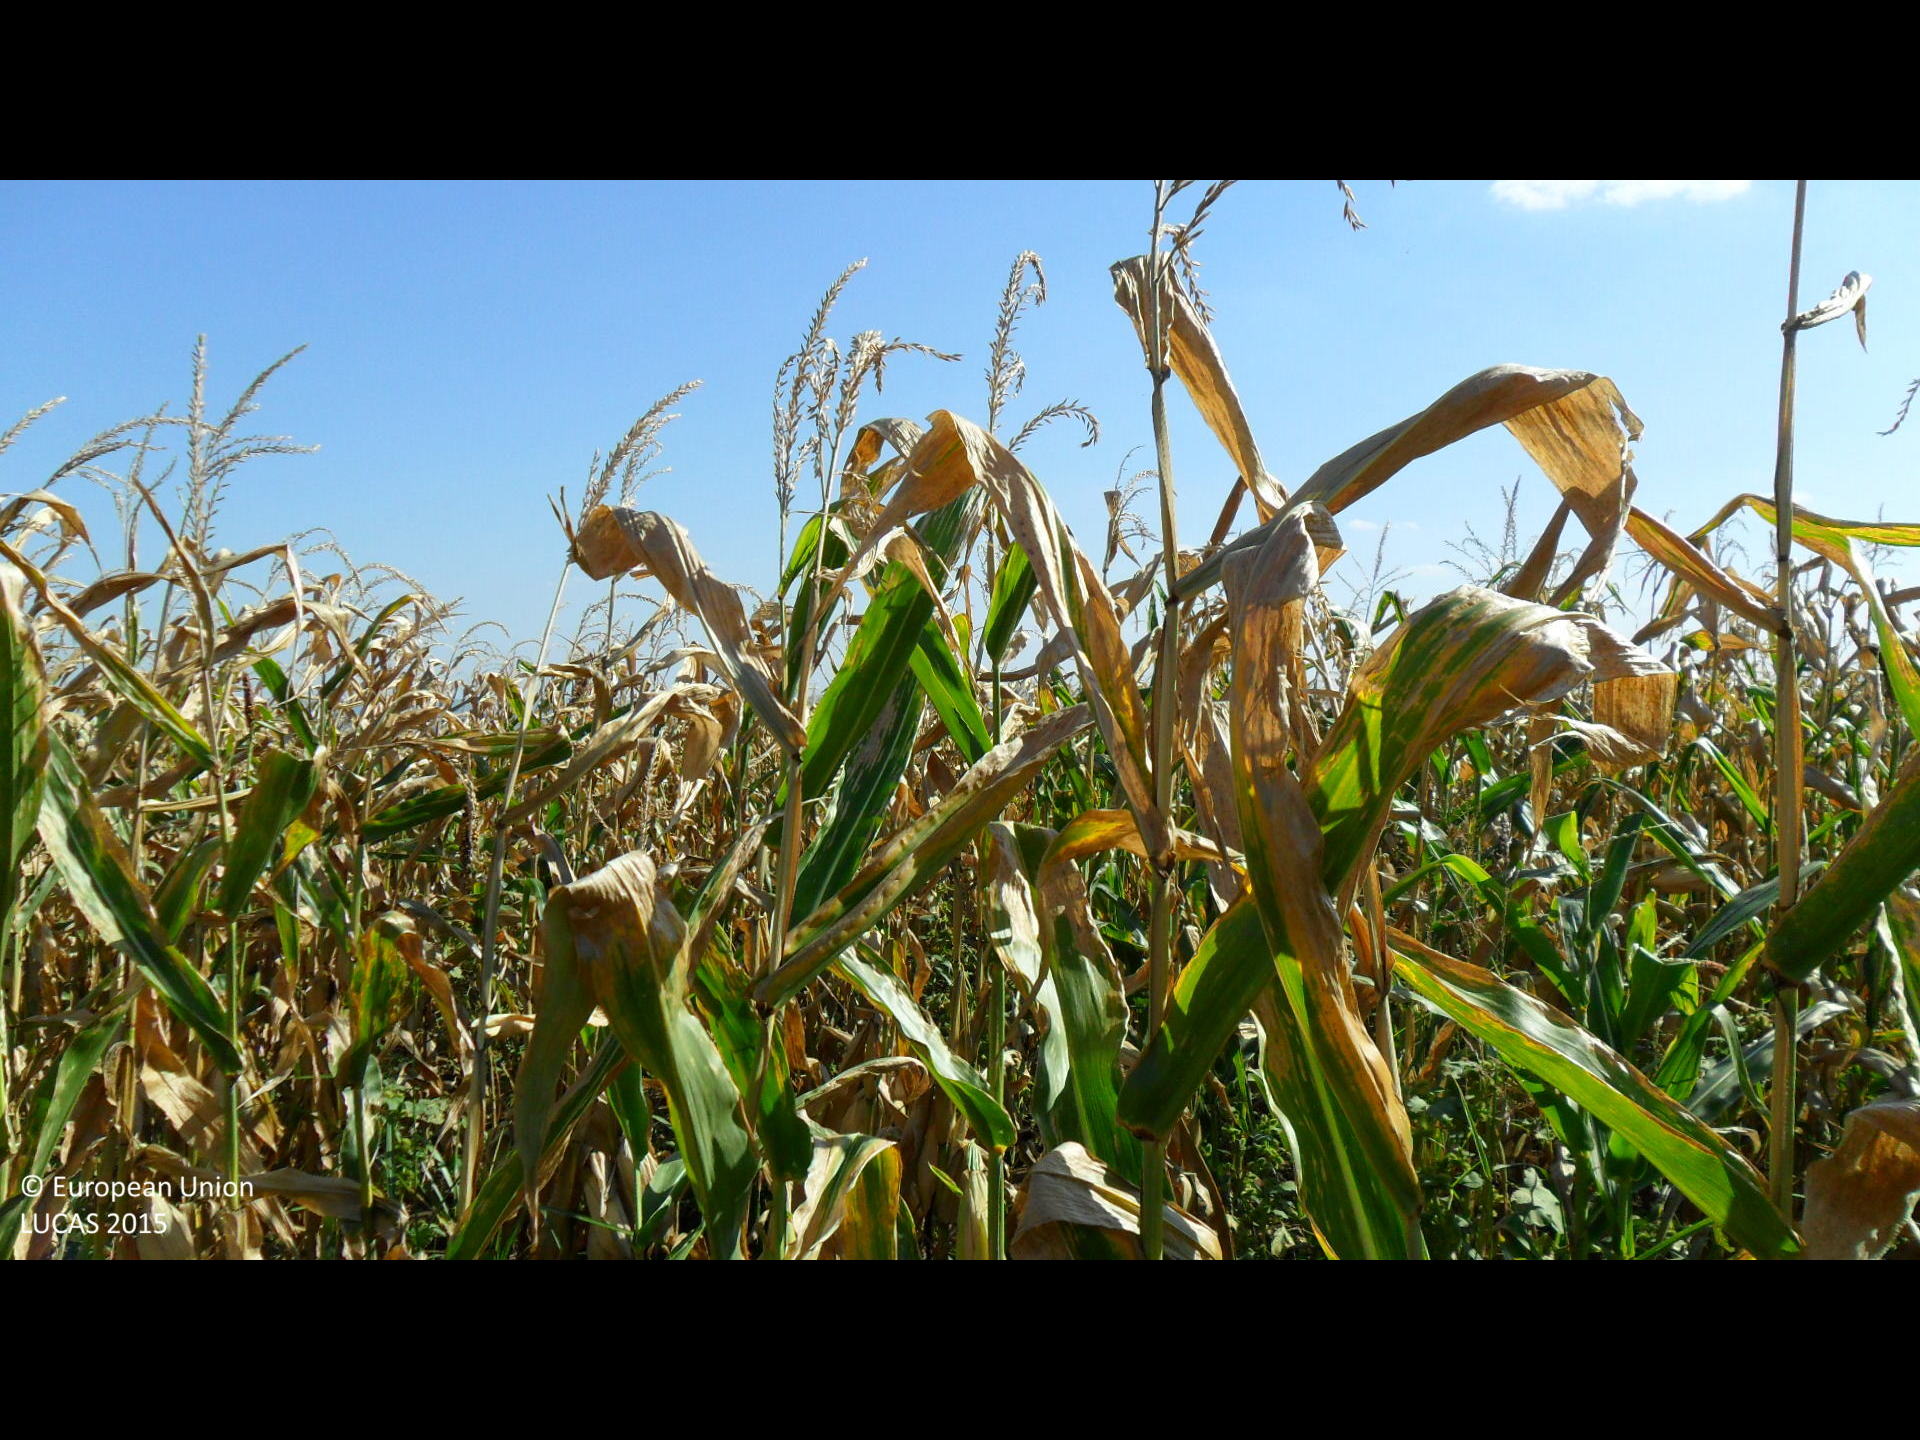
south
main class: Cropland
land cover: Maize
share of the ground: > 75 %
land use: Agriculture (excluding fallow land and kitchen gardens)
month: August
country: BG
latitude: 43.4865
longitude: 26.3353
